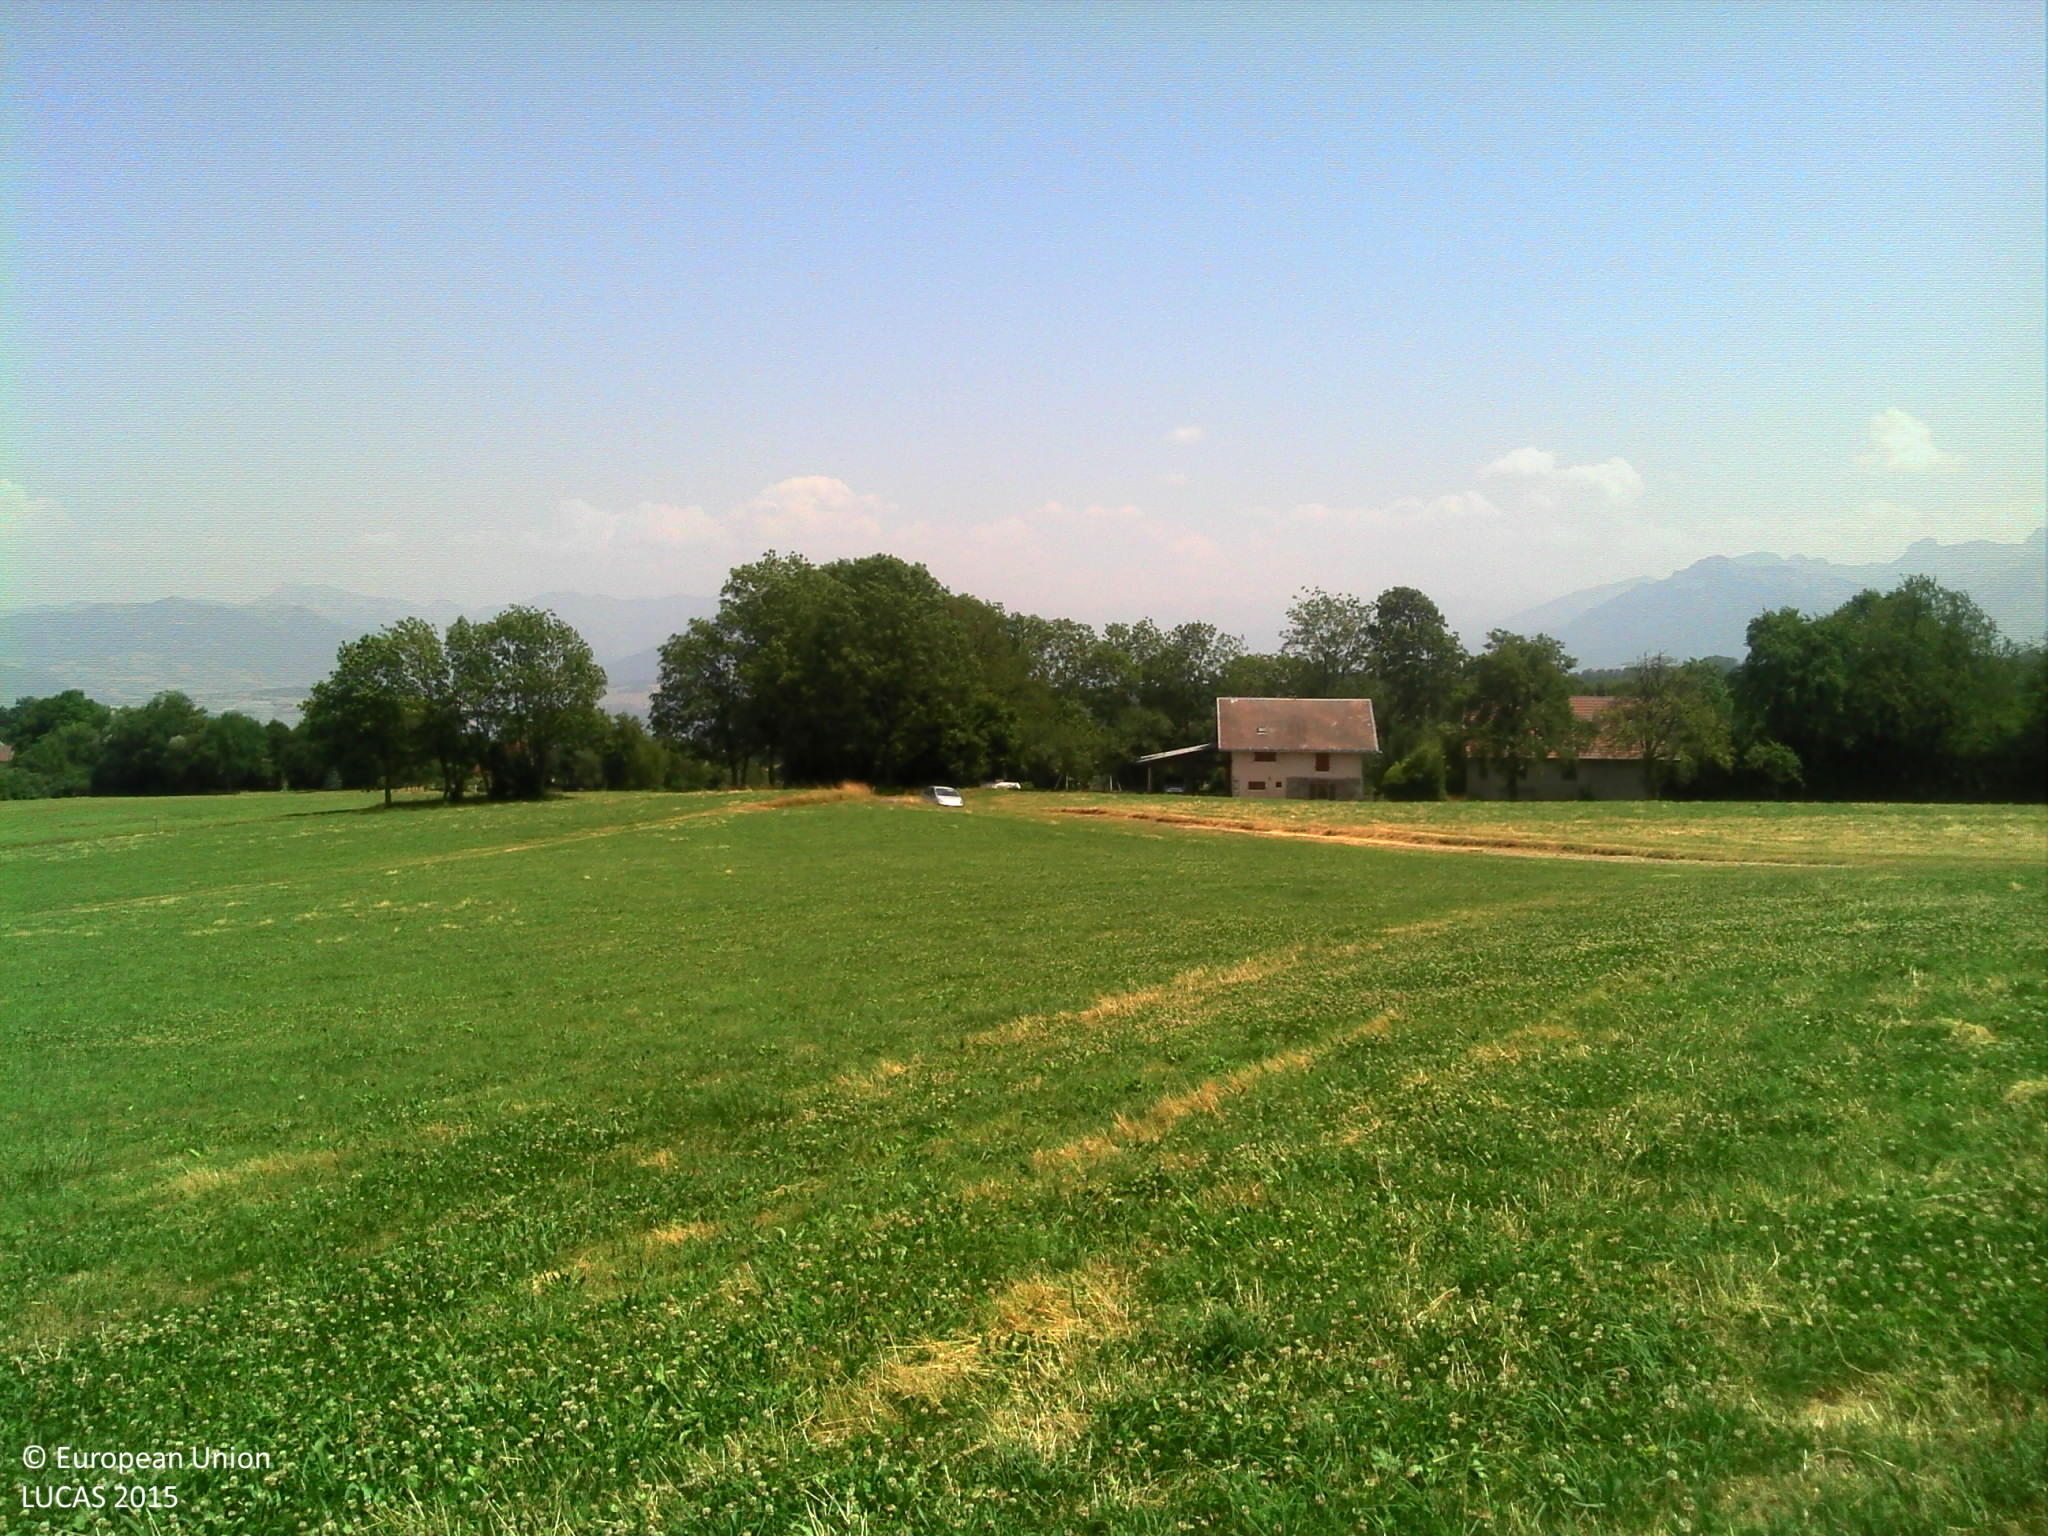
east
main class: Grassland
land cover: Grassland without tree/shrub cover
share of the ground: > 75 %
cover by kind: herbaceous plants 100 %
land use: Agriculture (excluding fallow land and kitchen gardens)
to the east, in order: Grassland without tree/shrub cover; Tracks; Paved roads, cycling and walking lanes; Grass margins; Broadleaved woodland; Tracks; Broadleaved woodland; Ditches and canals; Paved roads, cycling and walking lanes; Grass margins; Grassland with sparse tree/shrub cover
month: July
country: FR
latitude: 46.1039
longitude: 6.2132
